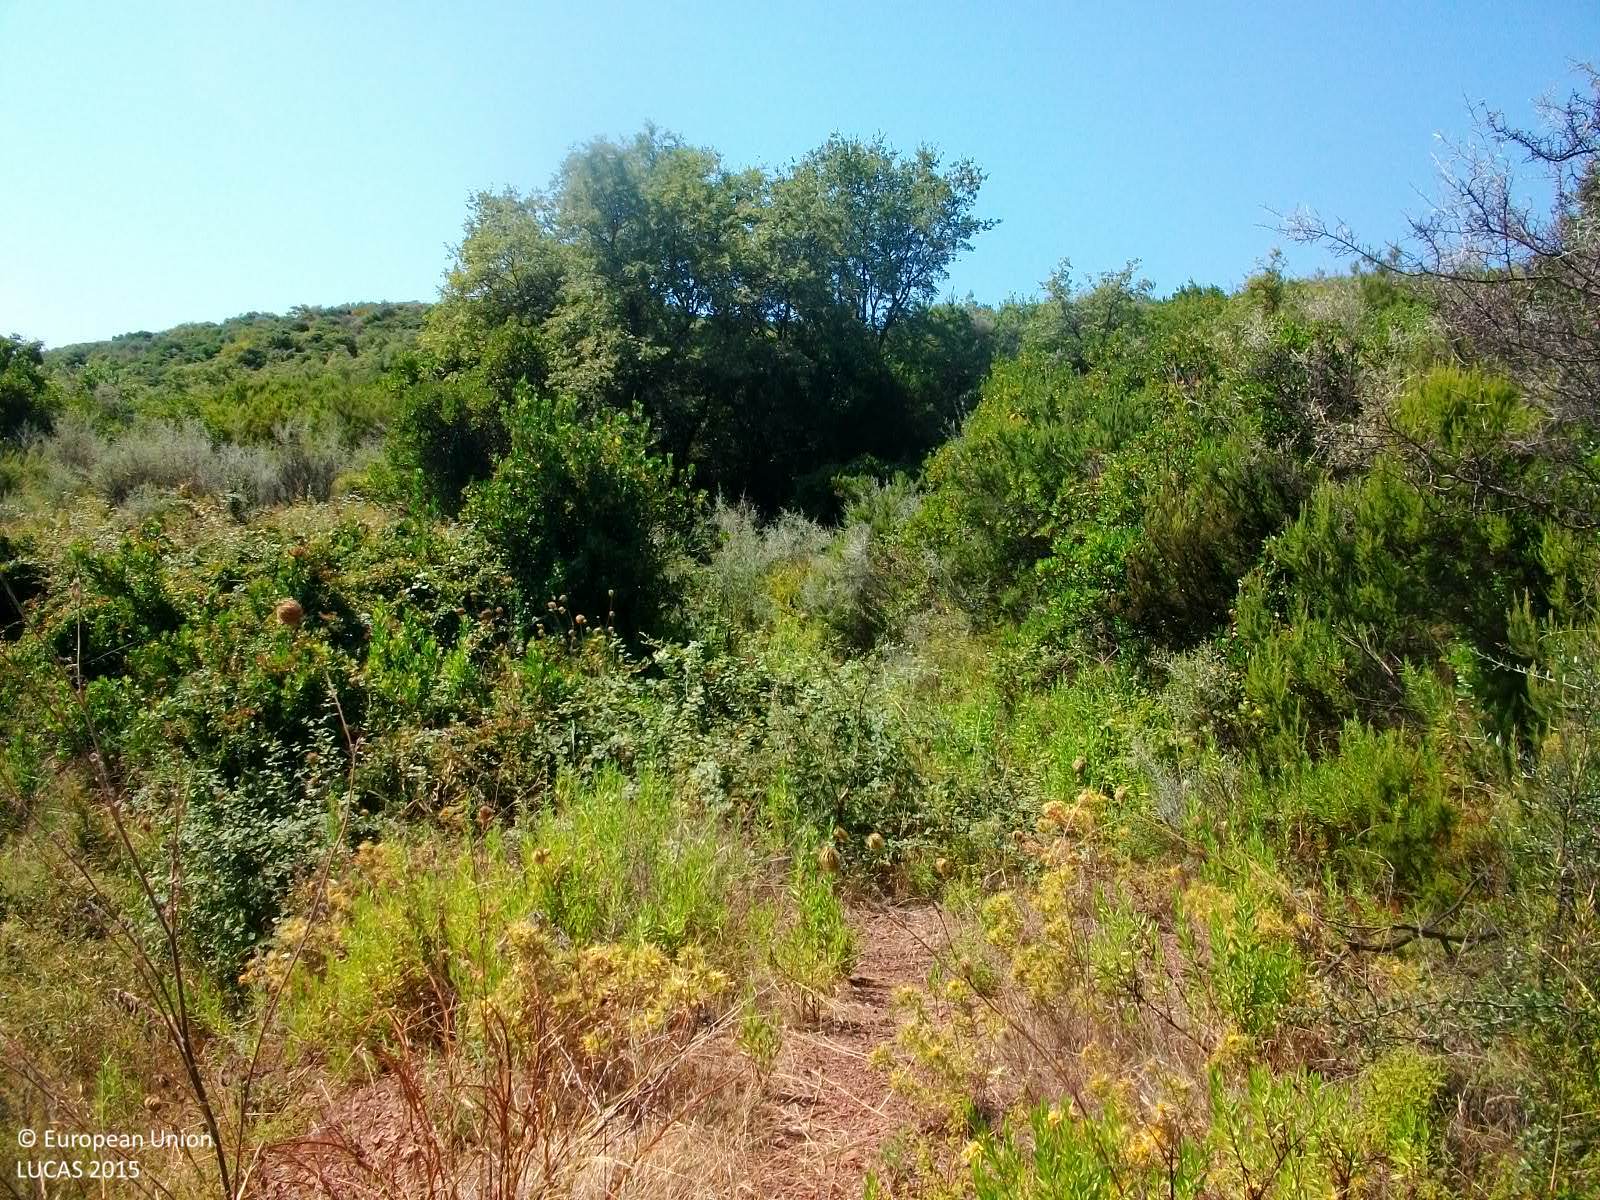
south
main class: Shrubland
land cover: Shrubland with sparse tree cover
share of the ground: > 75 %
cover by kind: shrubs 95 %, broadleaved forest trees 5 %
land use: Semi-natural and natural areas not in use
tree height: > 5 m
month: August
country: GR
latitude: 37.1620
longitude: 21.9020
